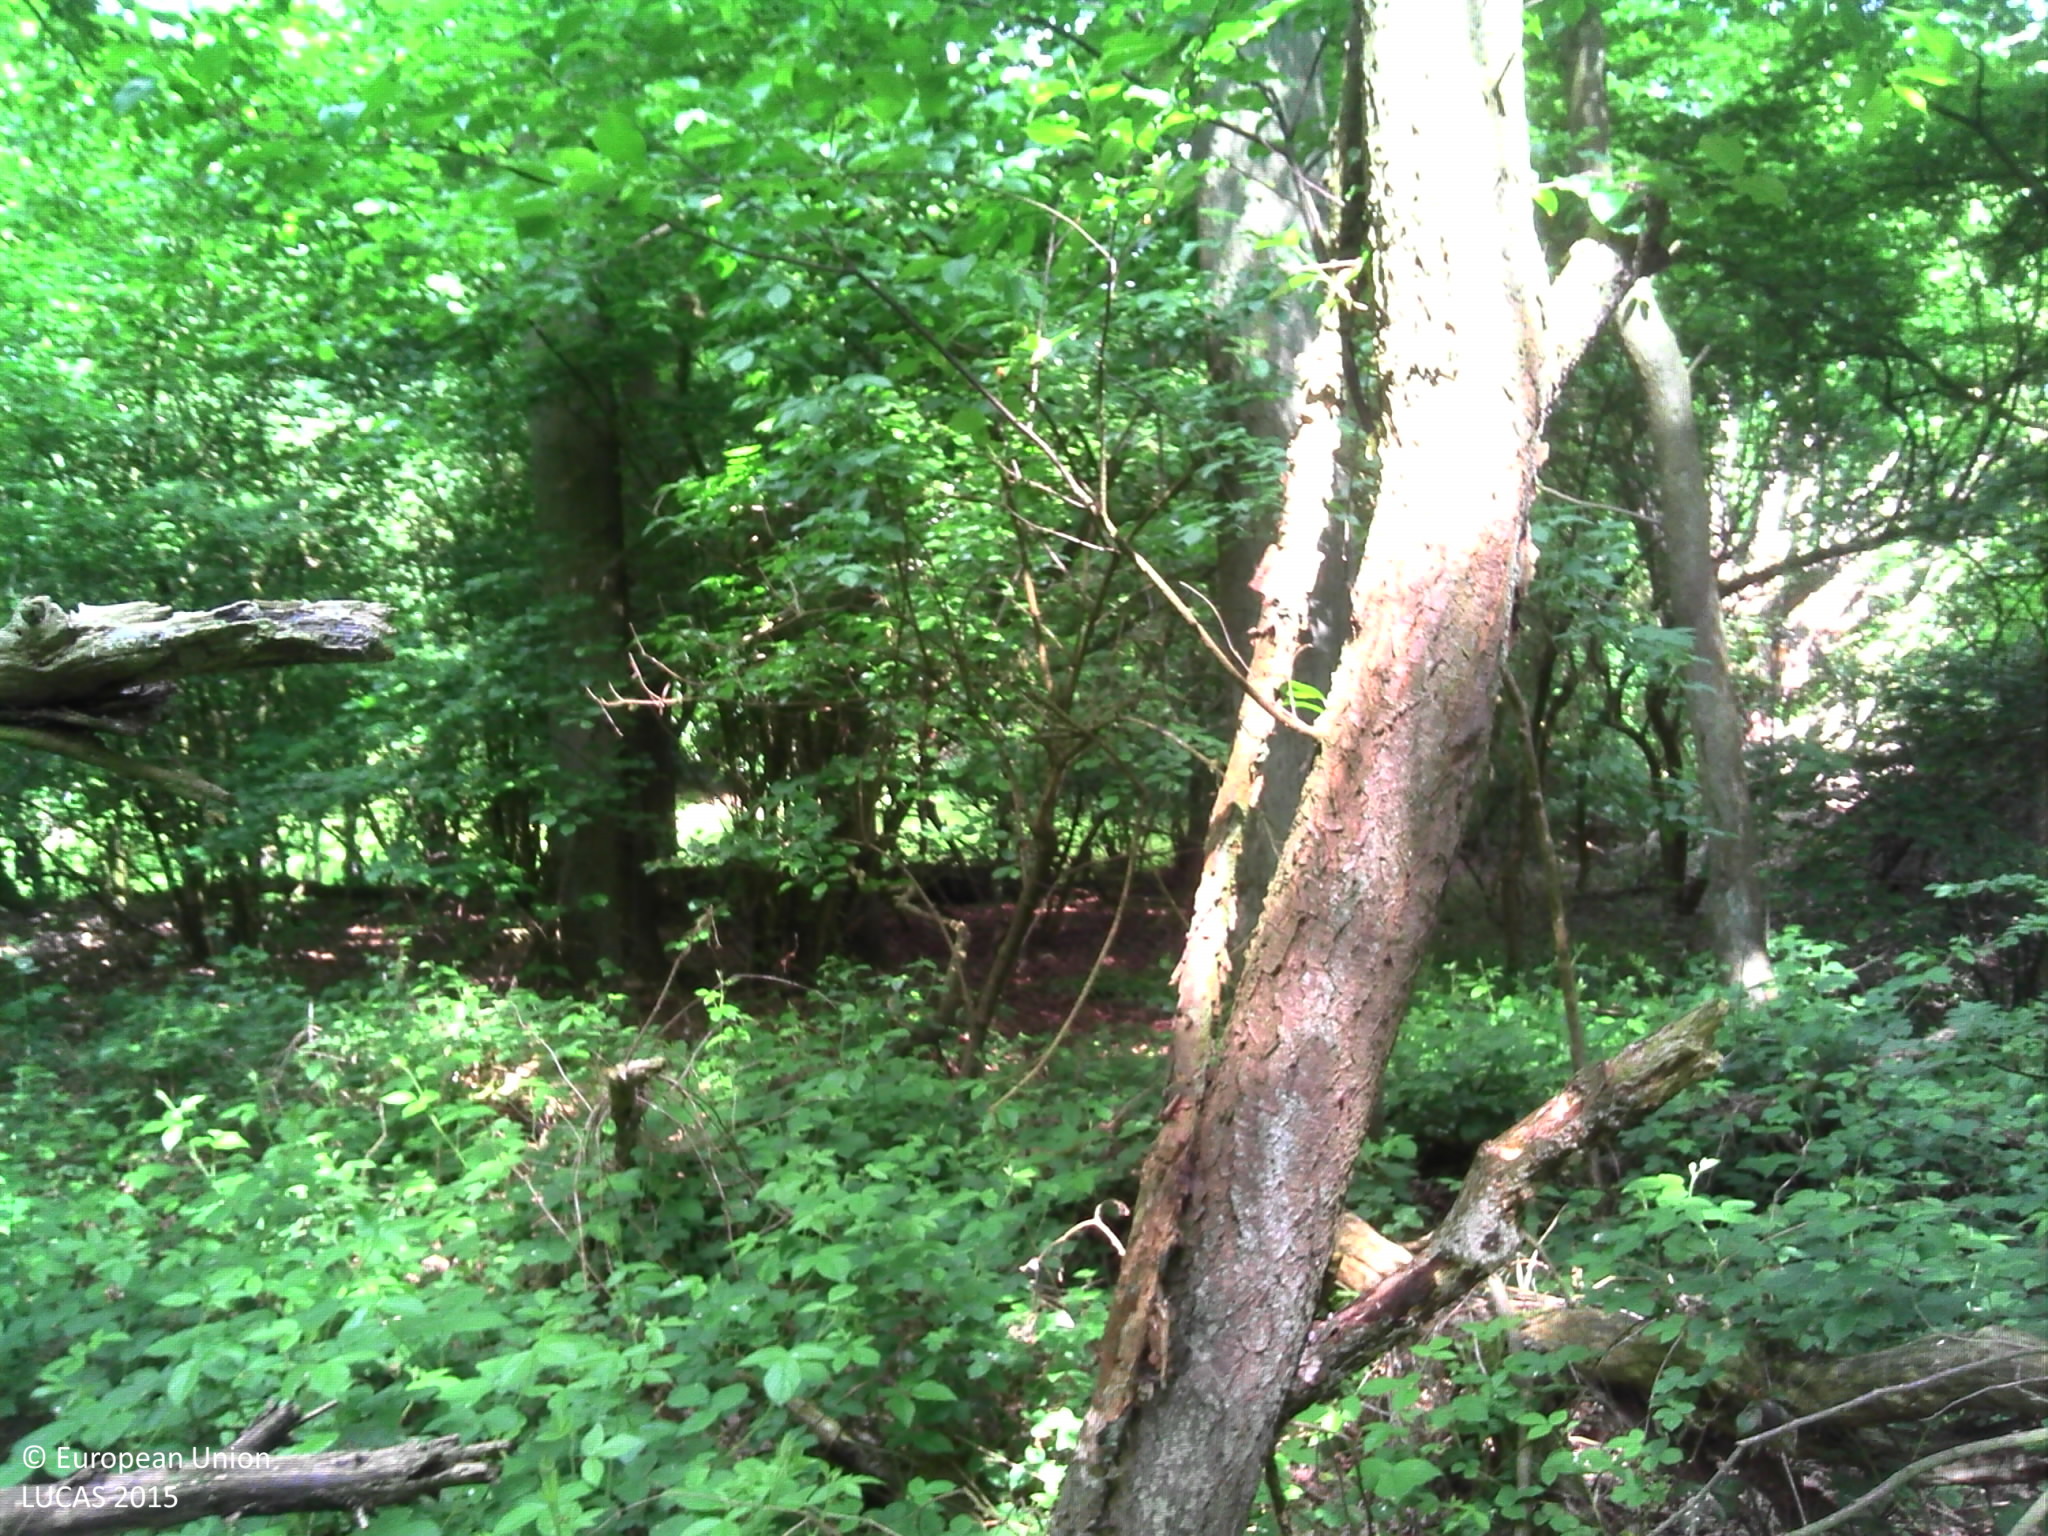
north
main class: Woodland
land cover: Broadleaved woodland
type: acidophilous oak and oak-birch forest
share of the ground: > 75 %
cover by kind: broadleaved forest trees 100 %
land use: Forestry
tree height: > 5 m
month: May
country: BE
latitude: 50.5564
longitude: 4.5050
